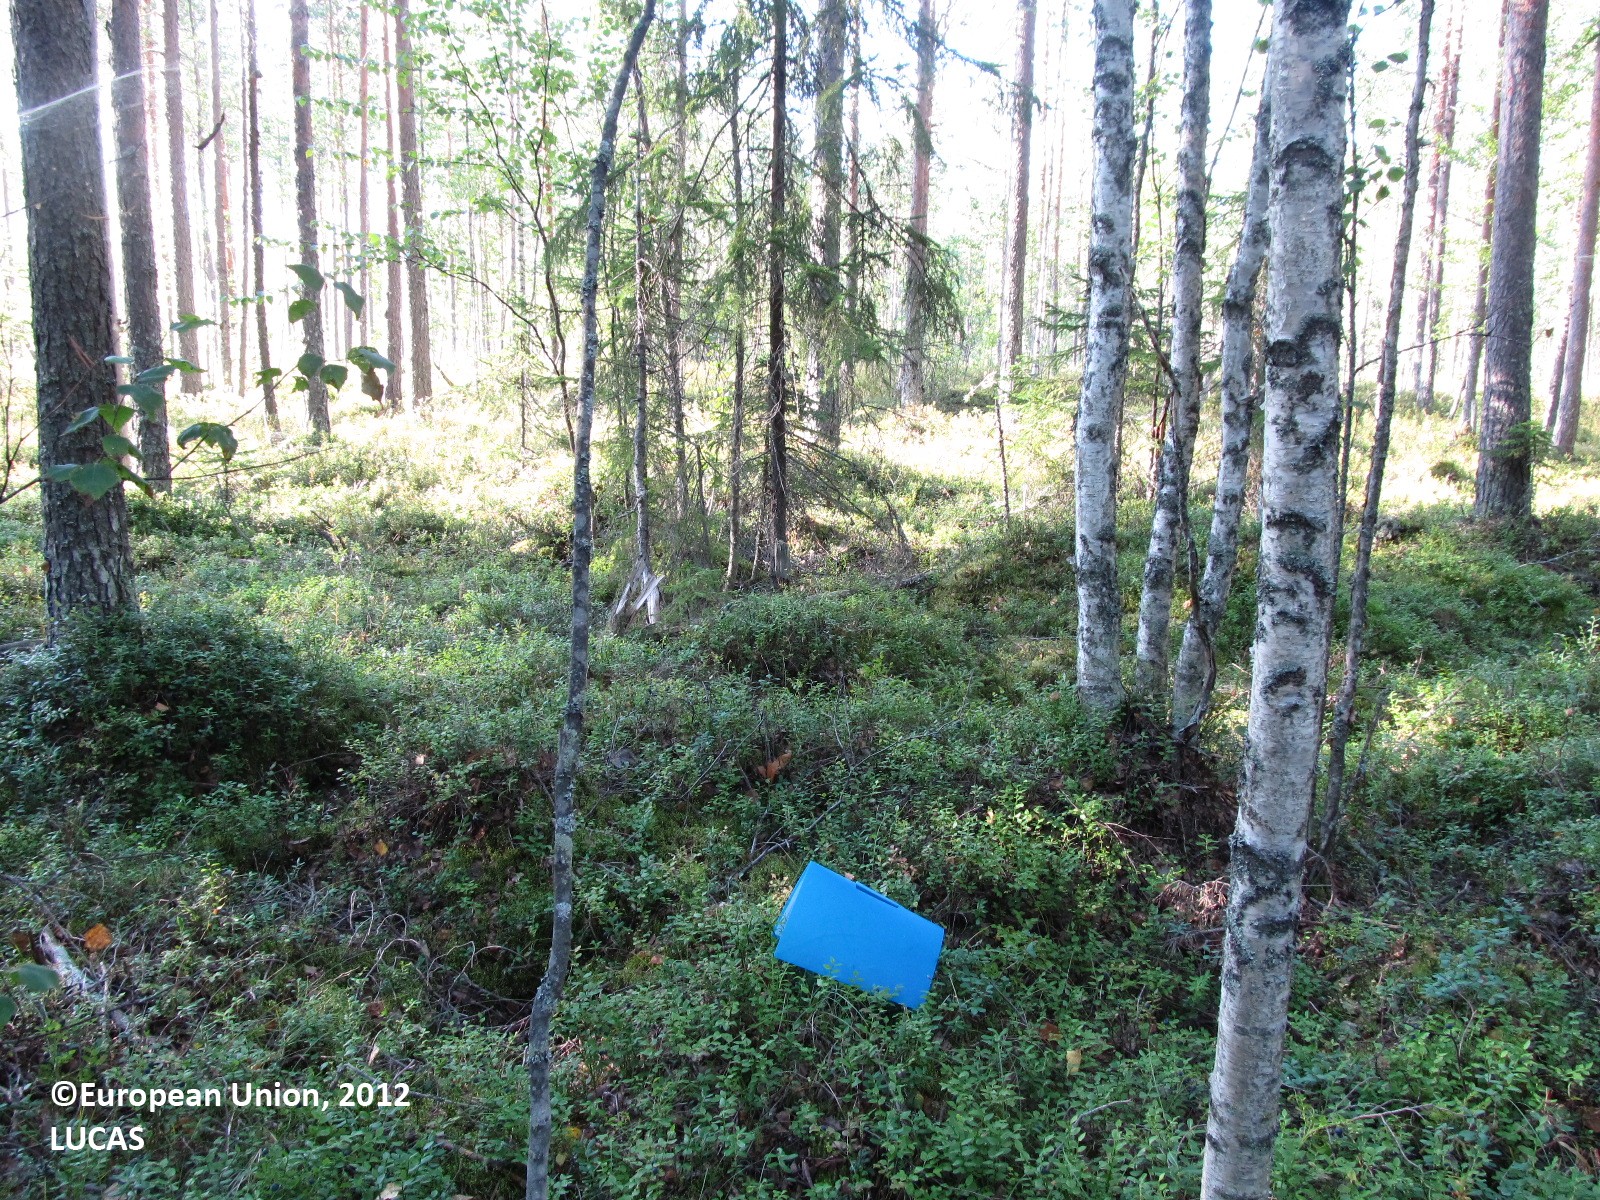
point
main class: Woodland
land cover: Pine dominated mixed woodland
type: boreal forest
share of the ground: 25 - 50 %
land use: Forestry
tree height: > 5 m
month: August
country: FI
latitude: 62.1410
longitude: 27.5719
